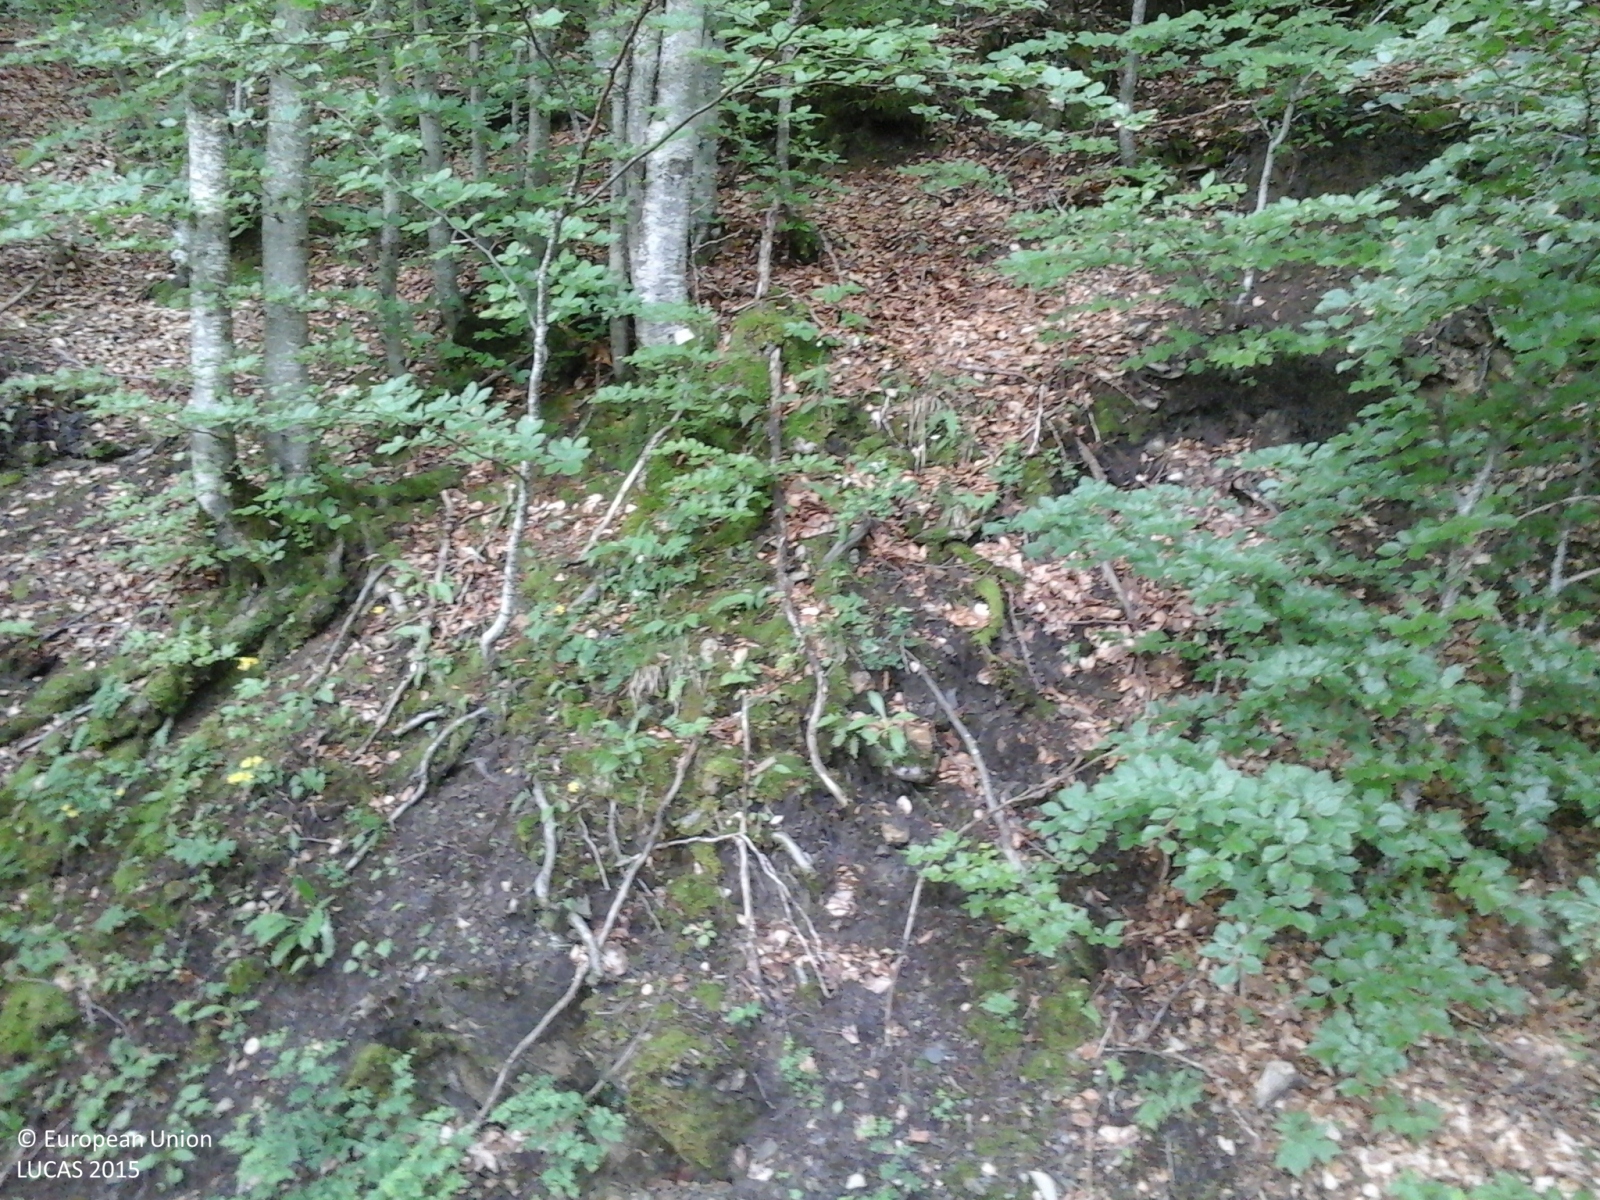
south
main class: Woodland
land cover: Broadleaved woodland
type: thermophilous deciduous forest
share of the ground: > 75 %
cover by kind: broadleaved forest trees 100 %
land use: Forestry
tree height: > 5 m
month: June
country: IT
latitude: 44.5660
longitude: 9.5603
